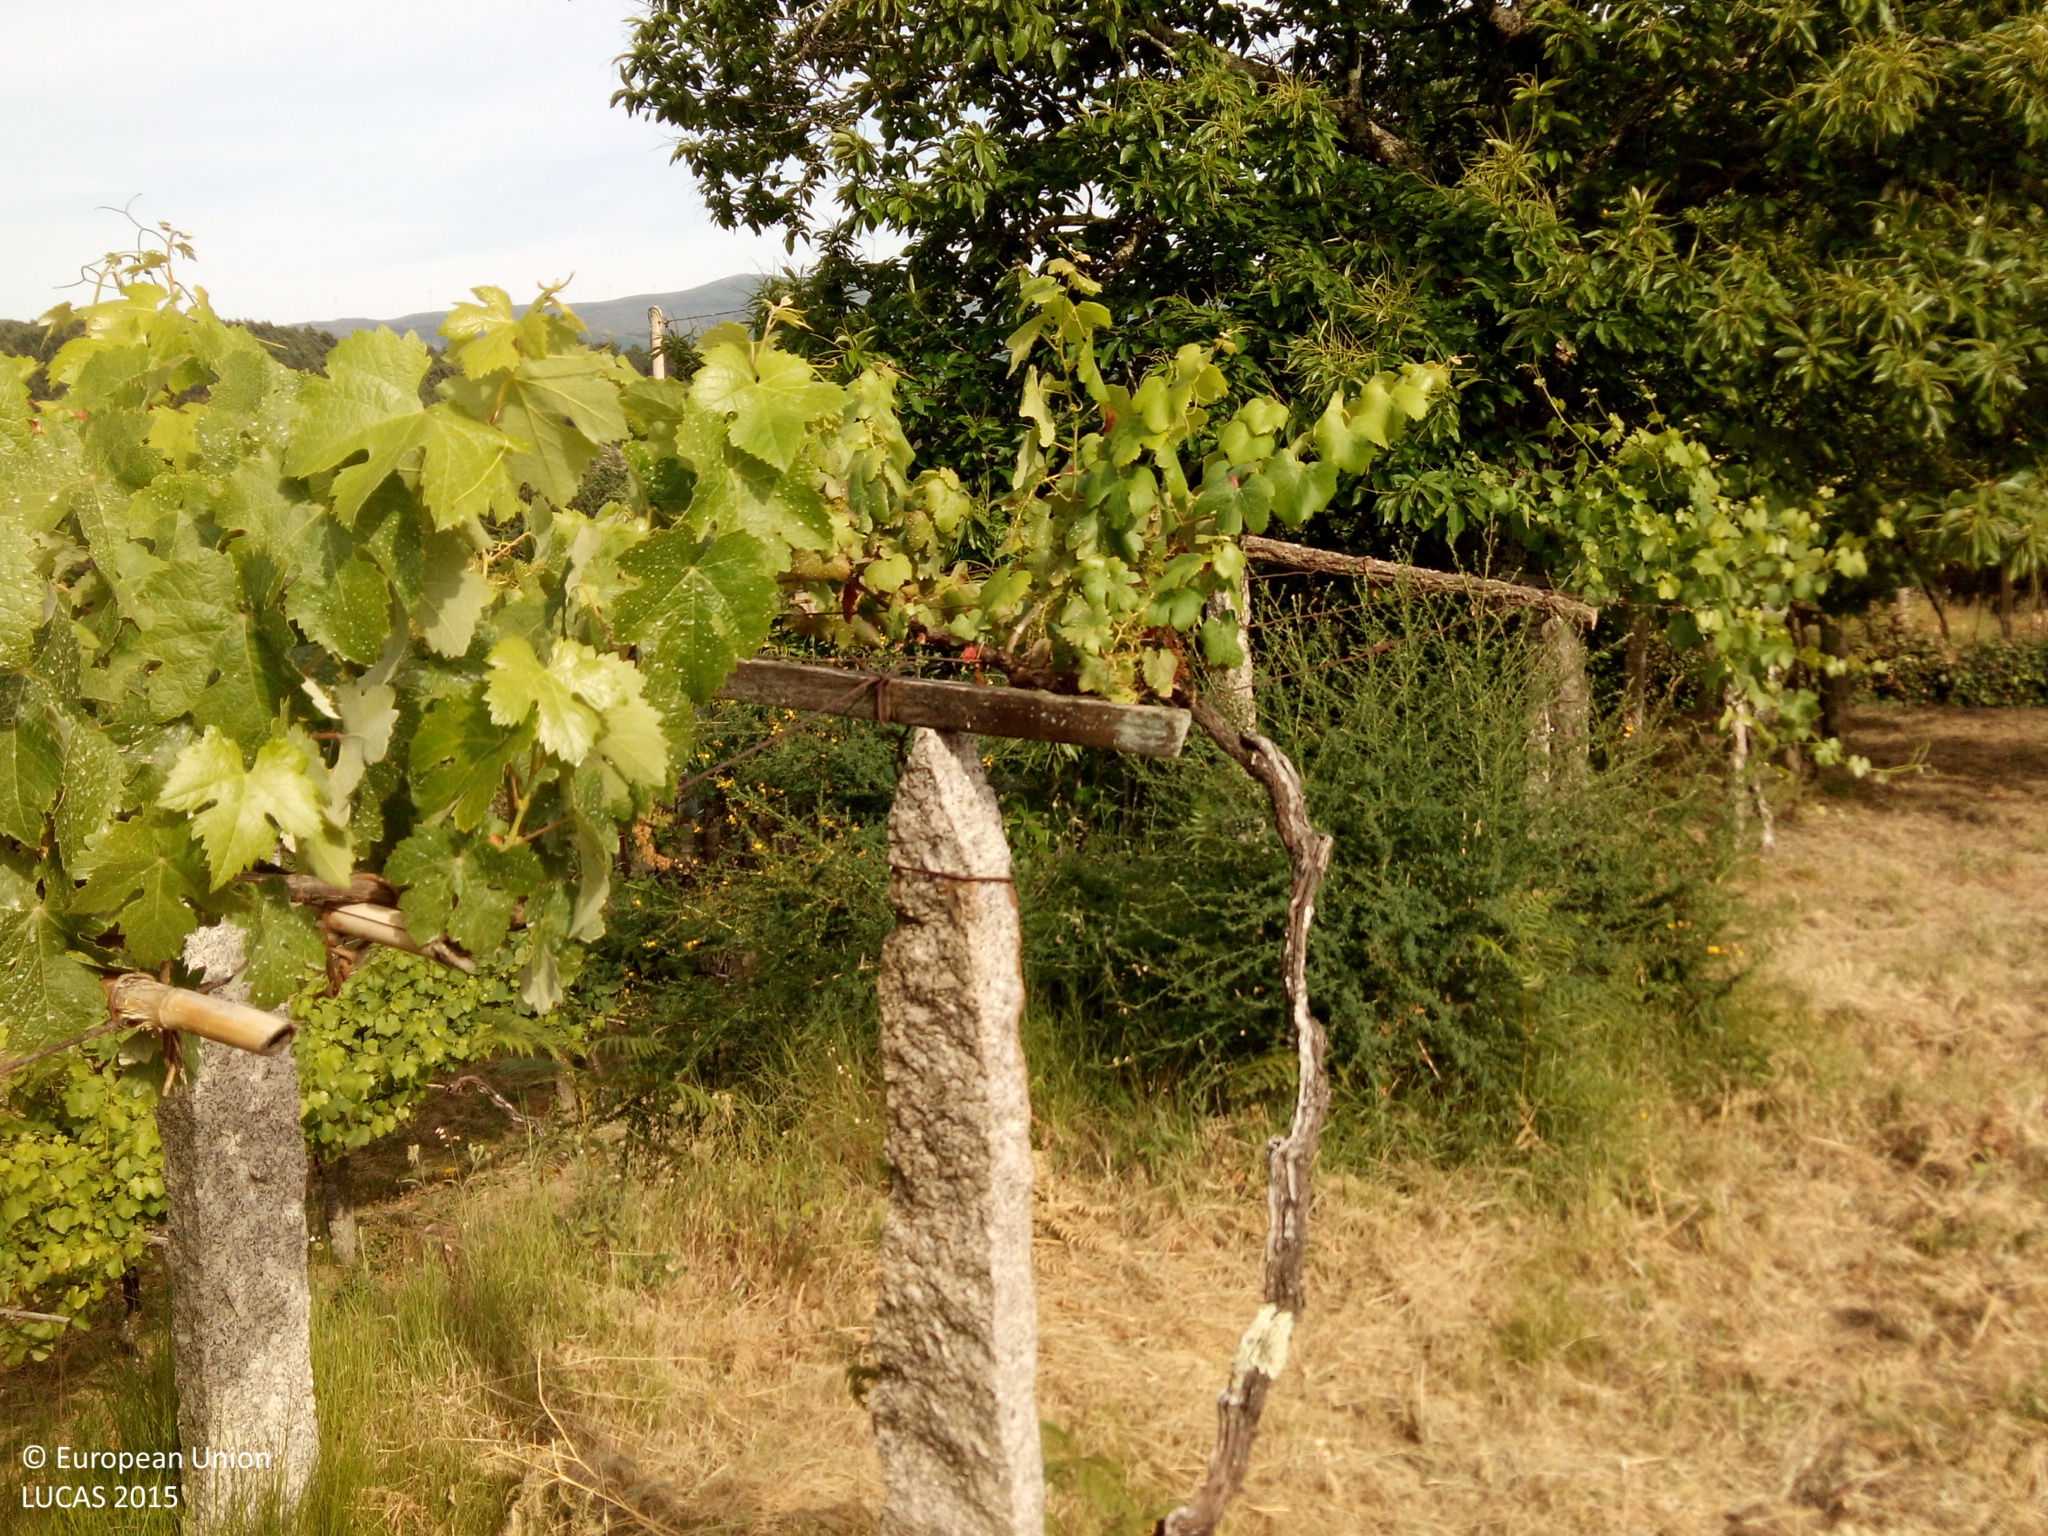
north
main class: Cropland
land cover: Vineyards
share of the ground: 50 - 75 %
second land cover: Grassland without tree/shrub cover
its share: 50 - 75 %
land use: Agriculture (excluding fallow land and kitchen gardens)
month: June
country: ES
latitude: 42.1170
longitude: -8.2893
